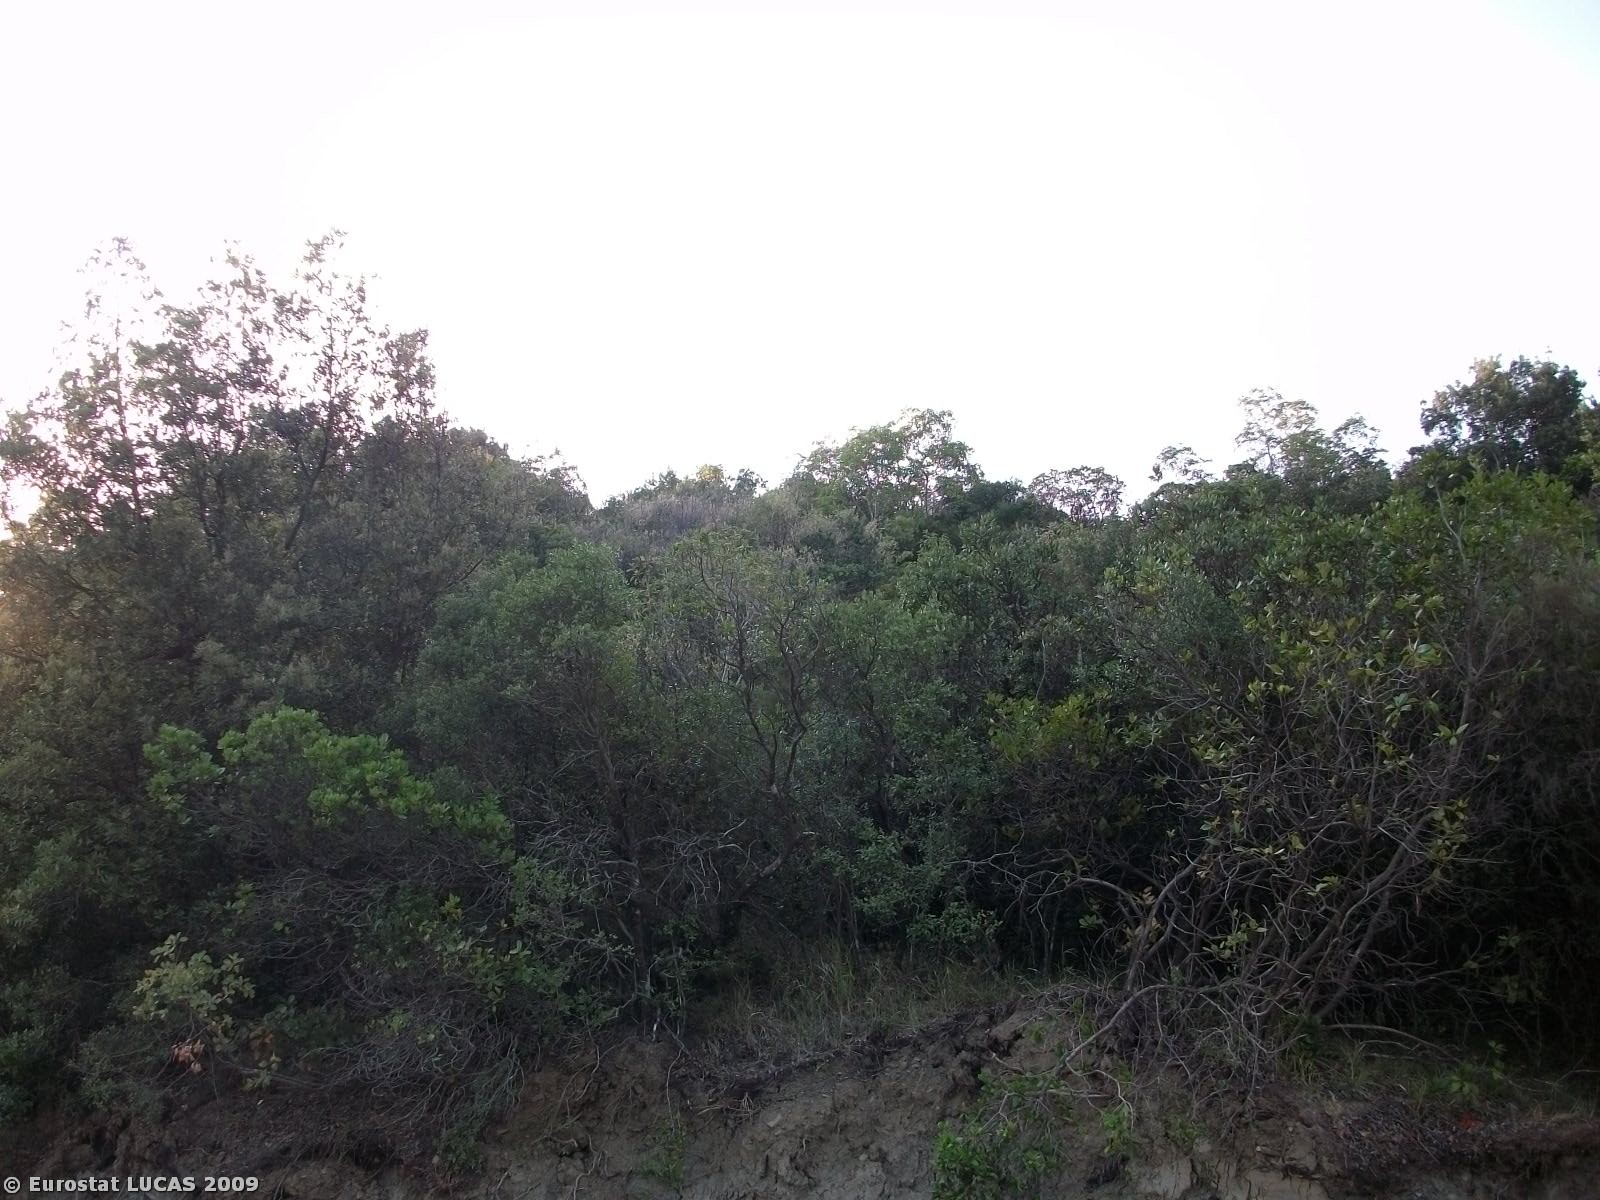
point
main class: Shrubland
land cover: Shrubland without tree cover
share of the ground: > 75 %
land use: Unused
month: August
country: GR
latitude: 39.0181
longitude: 21.5366
